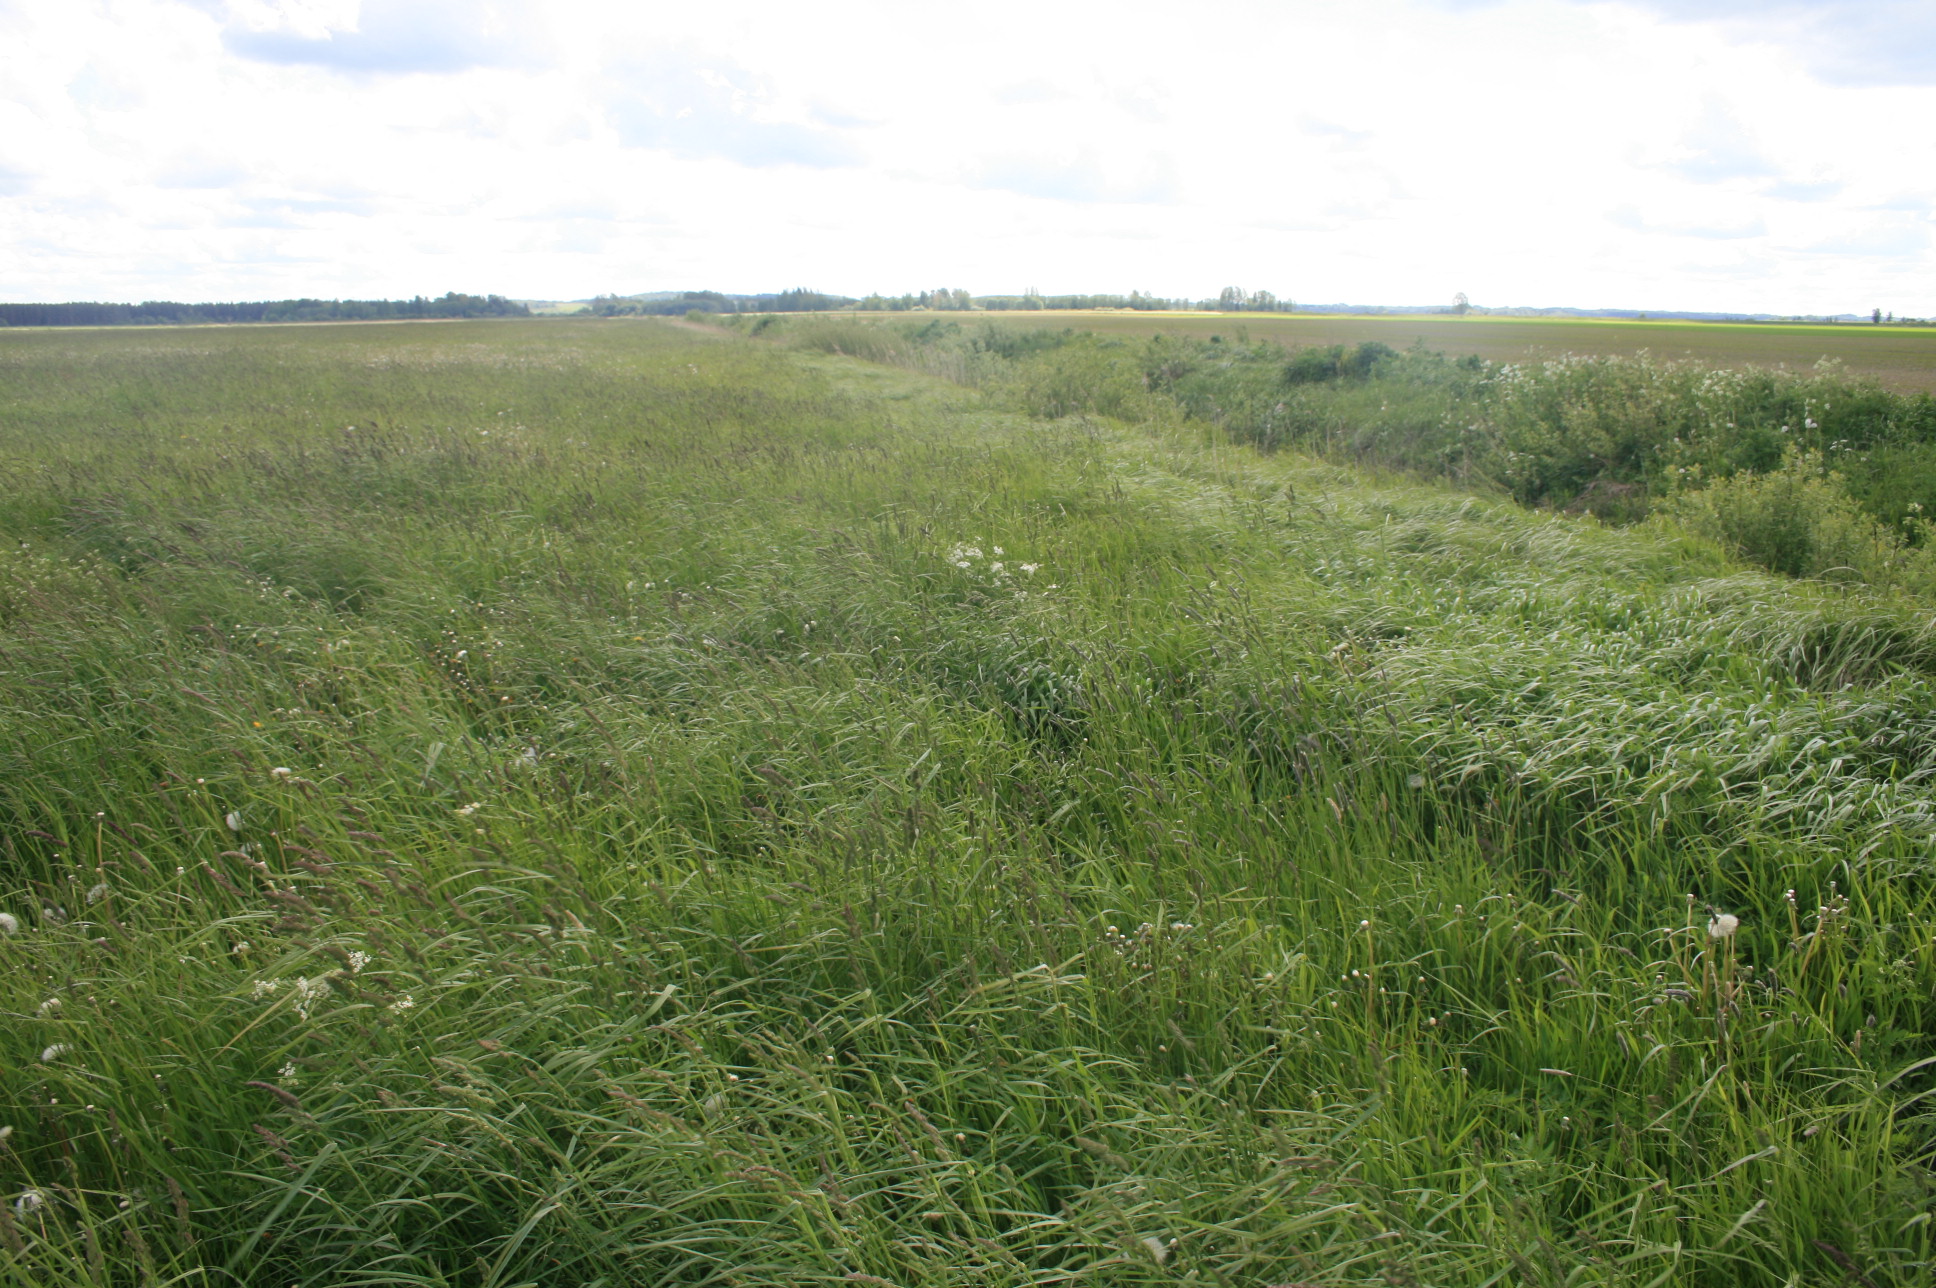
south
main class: Cropland
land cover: Oats
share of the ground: > 75 %
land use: Agriculture (excluding fallow land and kitchen gardens)
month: May
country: LT
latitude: 55.9888
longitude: 22.3520
